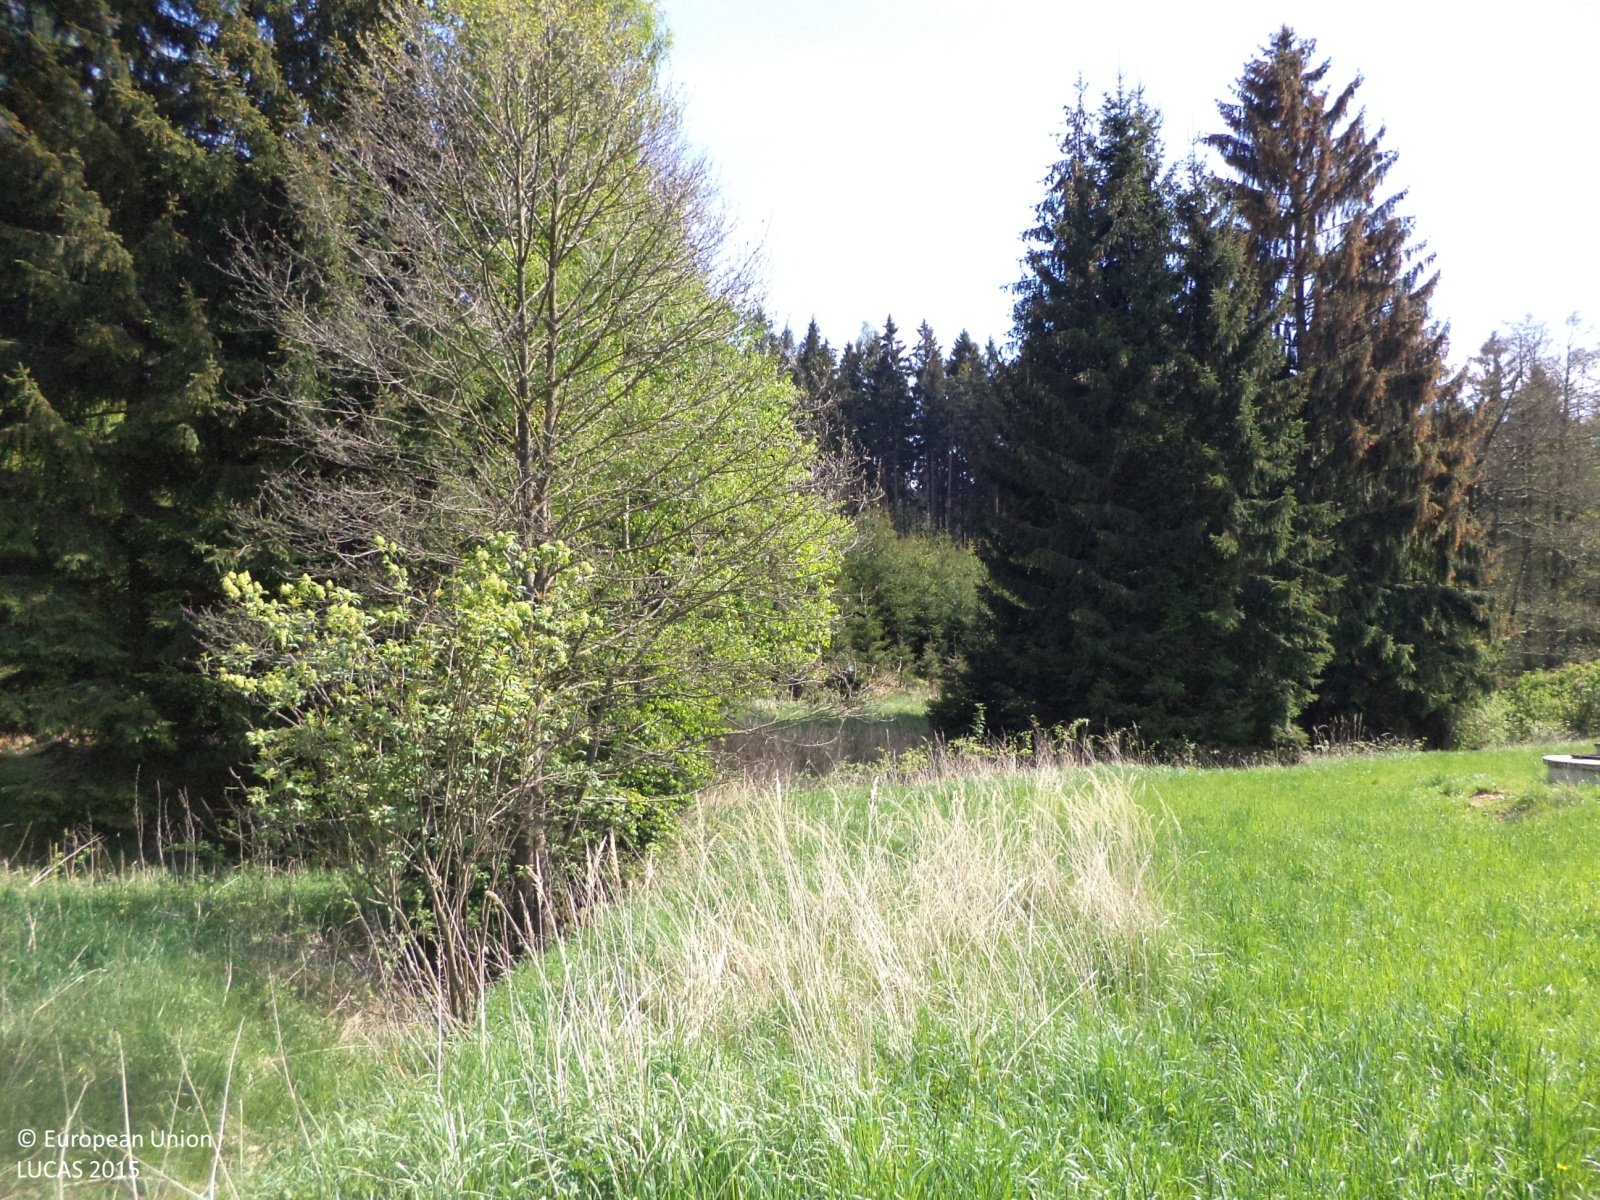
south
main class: Grassland
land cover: Grassland without tree/shrub cover
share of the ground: > 75 %
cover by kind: herbaceous plants 100 %
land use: Agriculture (excluding fallow land and kitchen gardens)
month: May
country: CZ
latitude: 49.4219
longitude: 15.0897
